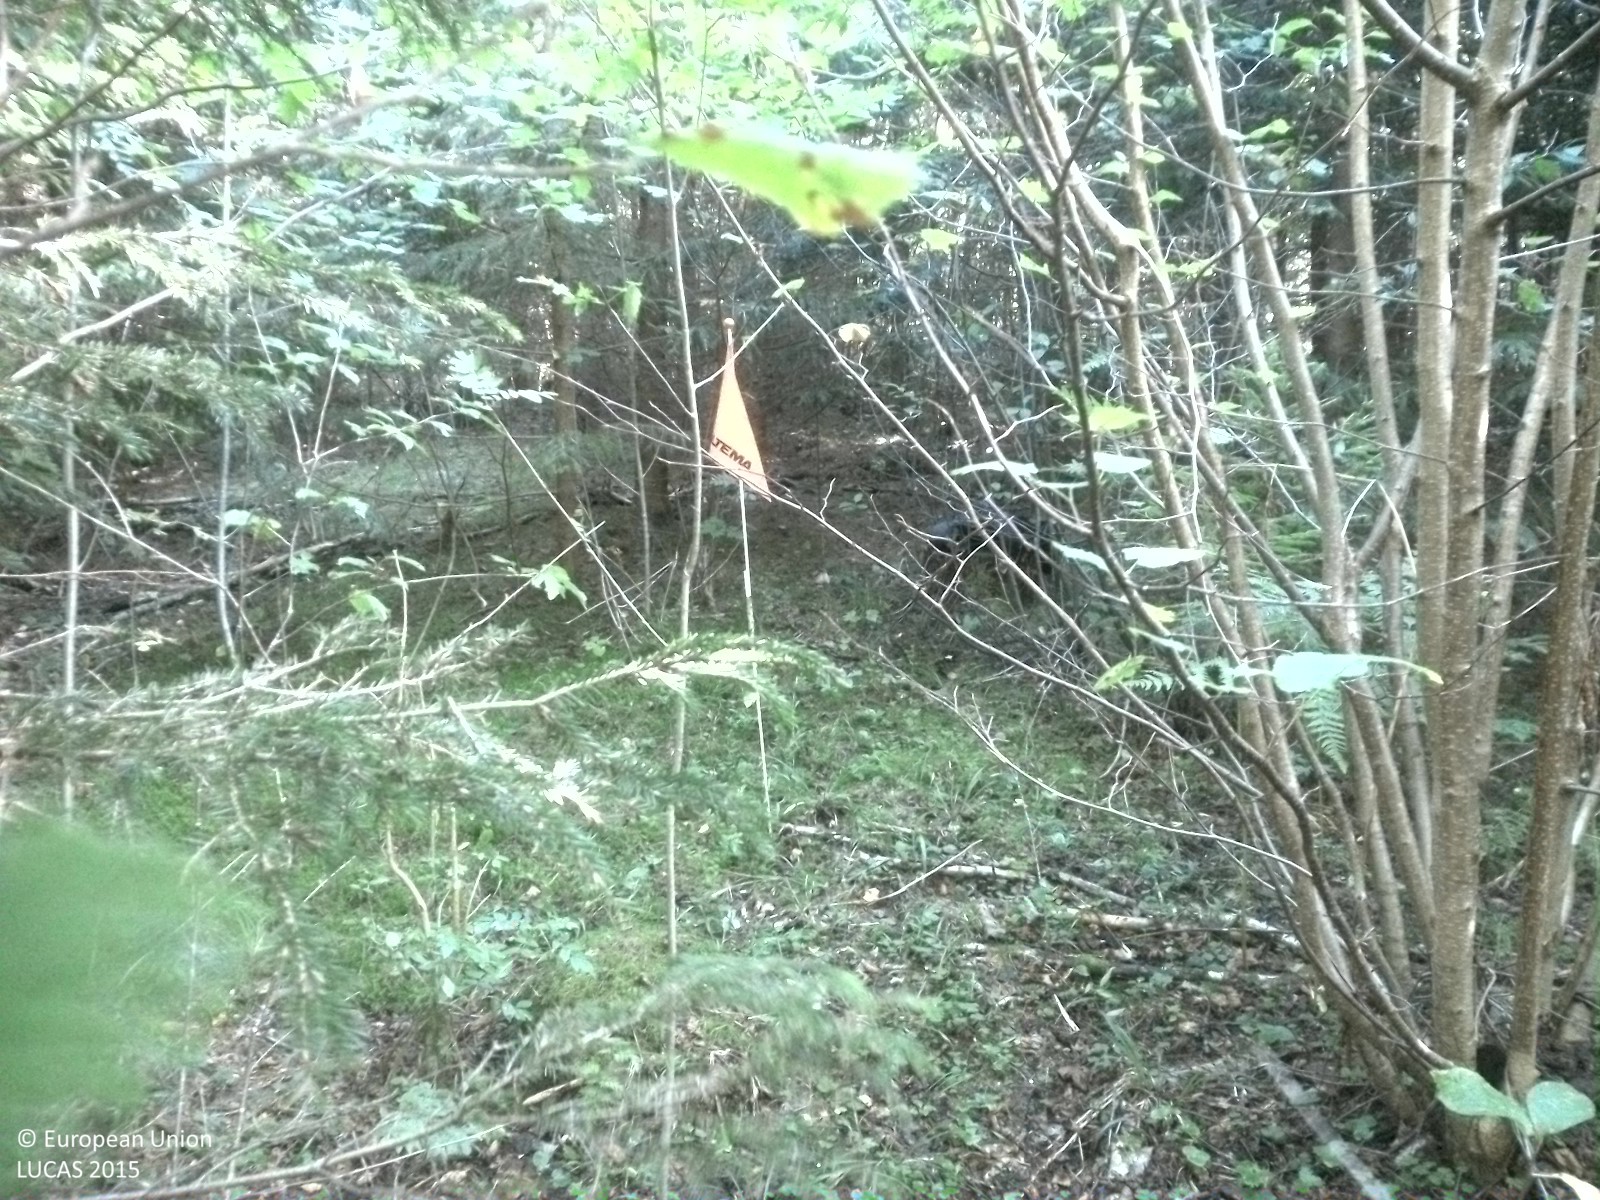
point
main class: Woodland
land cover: Spruce dominated mixed woodland
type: boreal forest
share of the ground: > 75 %
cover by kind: coniferous forest trees 50 %, broadleaved forest trees 30 %, lichens and mosses 10 %, herbaceous plants 5 %, unconsolidated bare surface 5 %
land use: Forestry
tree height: < 5 m
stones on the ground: < 10 %
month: August
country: SE
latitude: 58.6503
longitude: 14.9736
